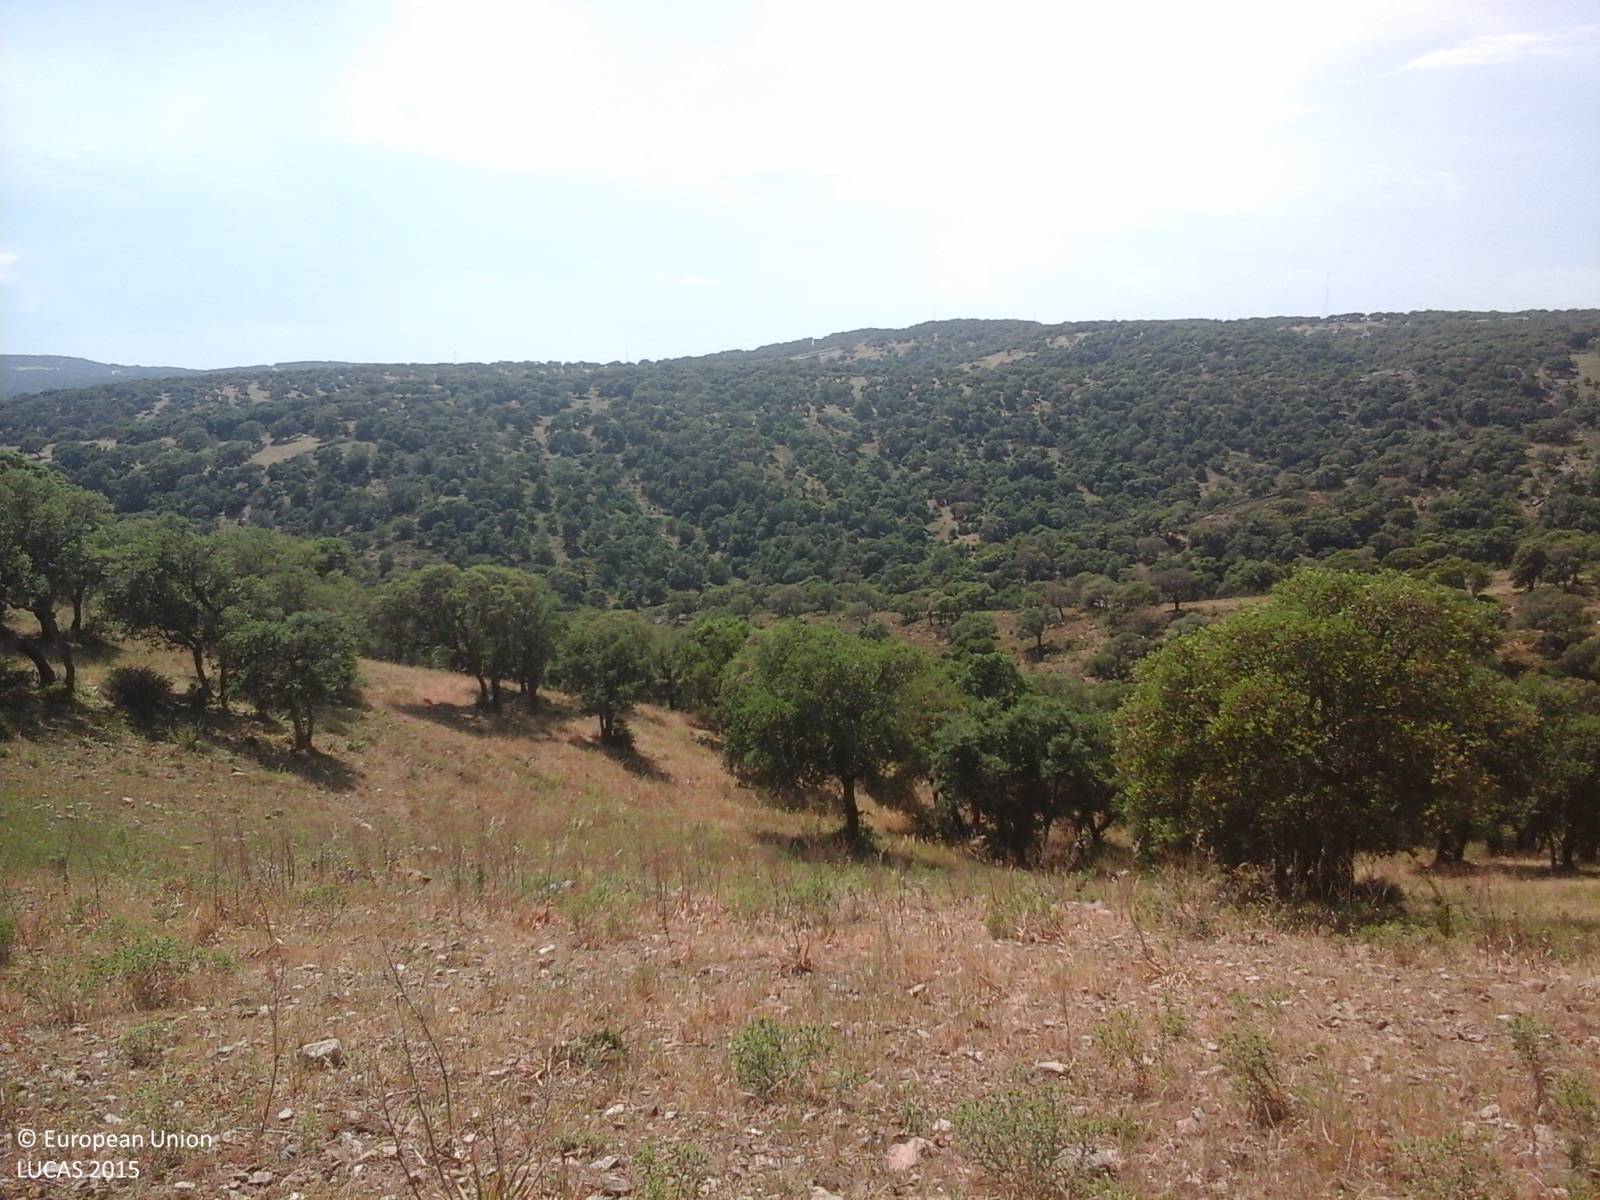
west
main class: Woodland
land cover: Broadleaved woodland
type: broadleaved evergreen forest
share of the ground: 25 - 50 %
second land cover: Spontaneously vegetated surfaces
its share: 25 - 50 %
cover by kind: broadleaved forest trees 90 %, herbaceous plants 5 %, unconsolidated bare surface 5 %
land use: Forestry
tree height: > 5 m
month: June
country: IT
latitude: 40.5189
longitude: 9.4011
